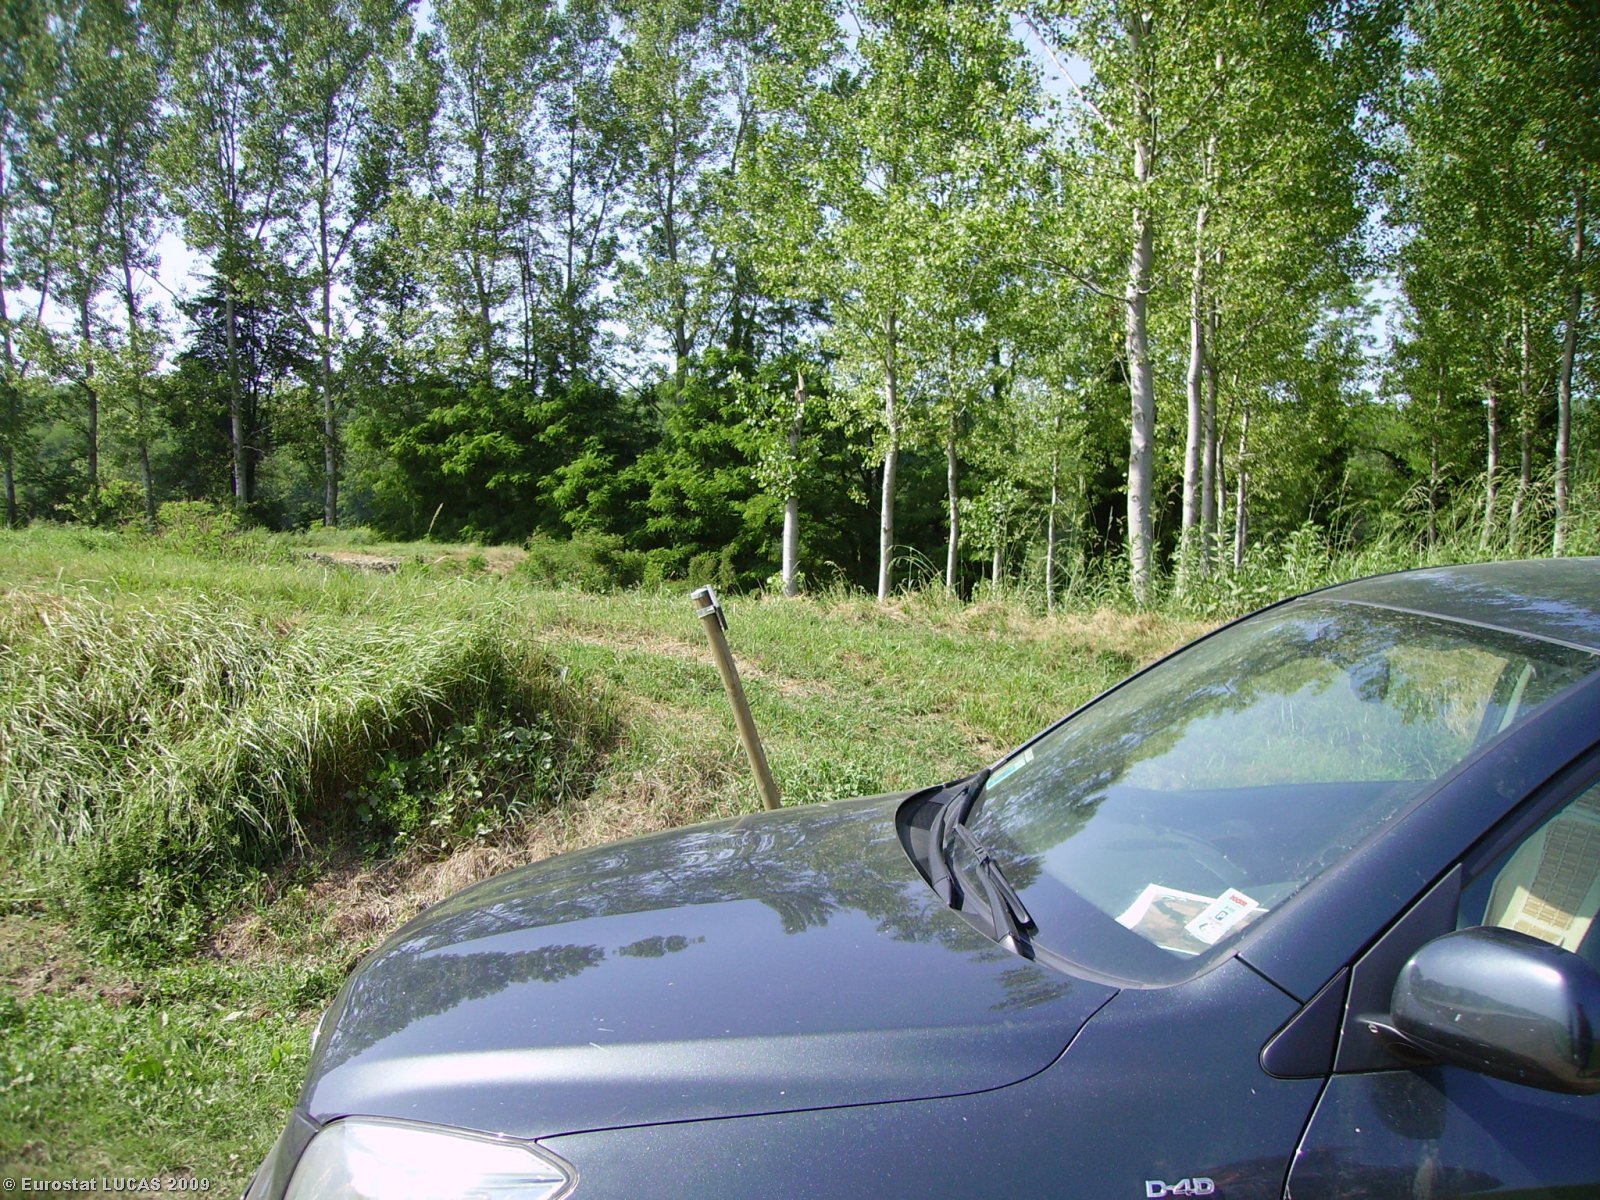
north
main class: Cropland
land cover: Rice
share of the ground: 10 - 25 %
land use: Agriculture (excluding fallow land and kitchen gardens)
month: May
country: IT
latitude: 45.1414
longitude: 9.2765
